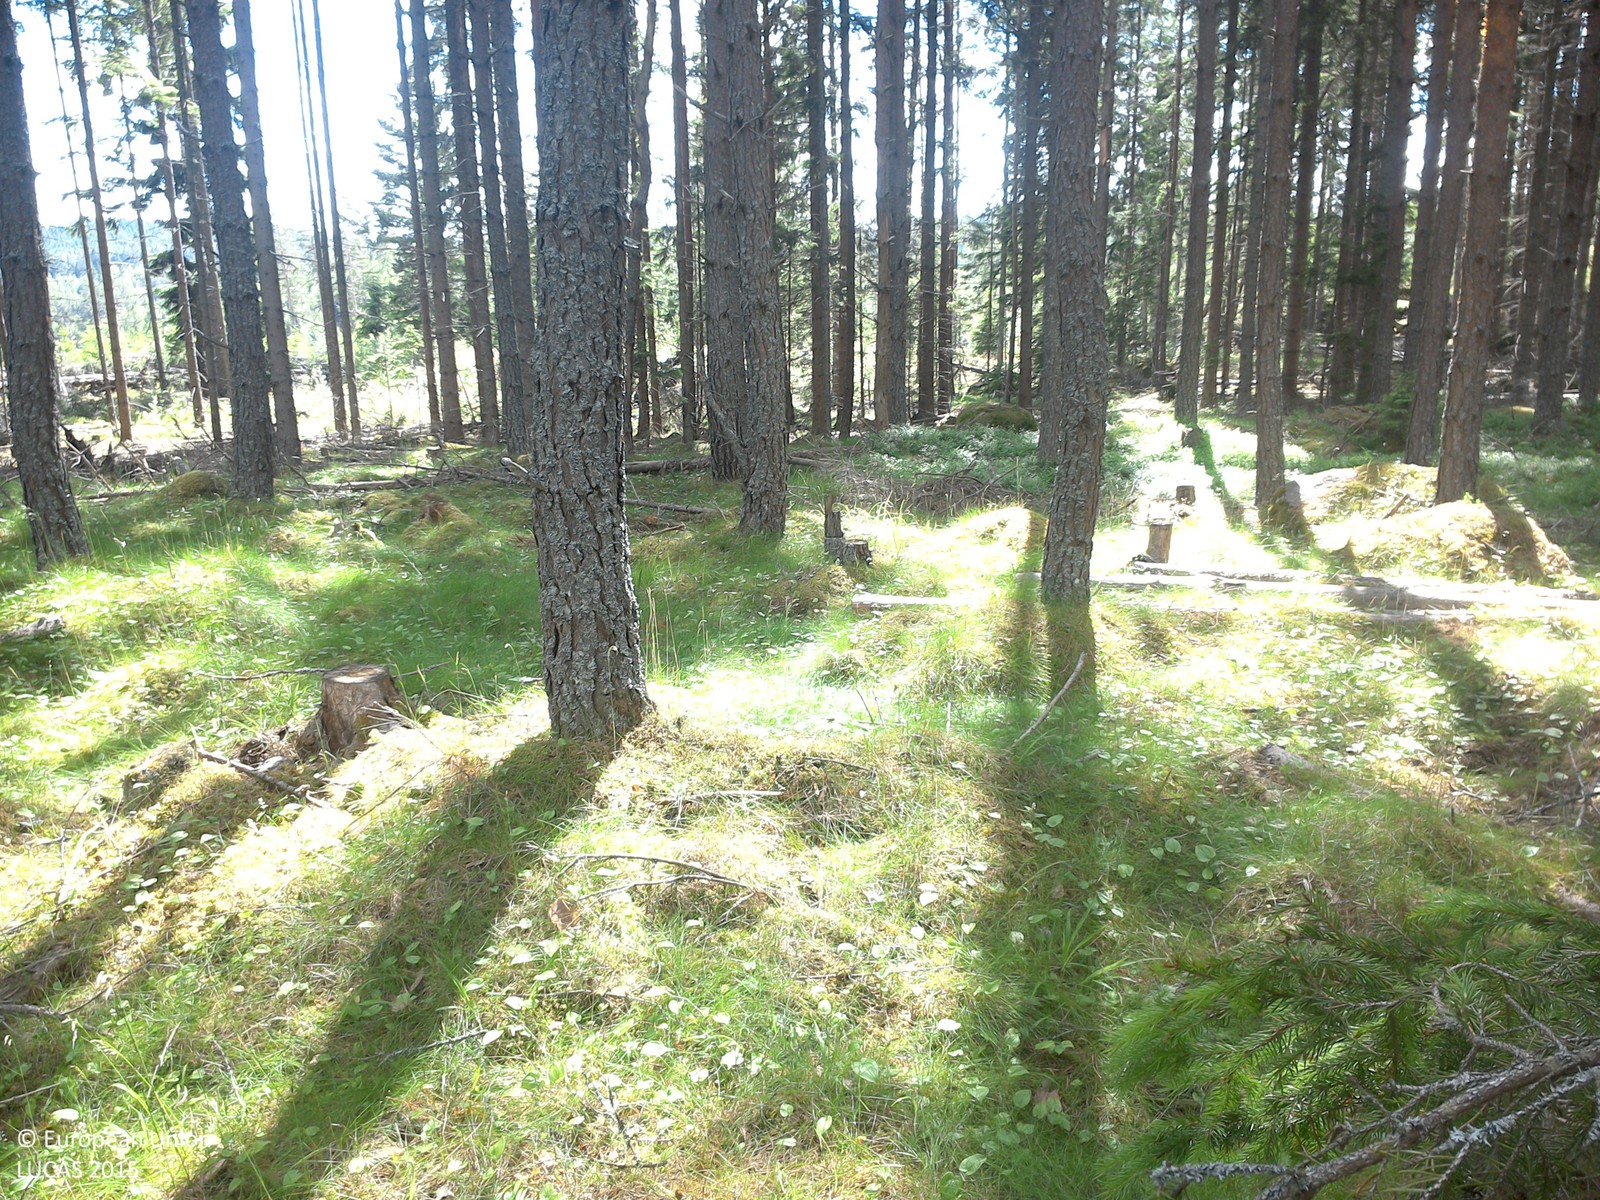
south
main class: Woodland
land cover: Pine dominated coniferous woodland
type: boreal forest
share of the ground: 50 - 75 %
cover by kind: coniferous forest trees 65 %, lichens and mosses 30 %, herbaceous plants 5 %
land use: Forestry
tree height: > 5 m
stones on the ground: < 10 %
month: June
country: SE
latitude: 58.0528
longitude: 15.5023
